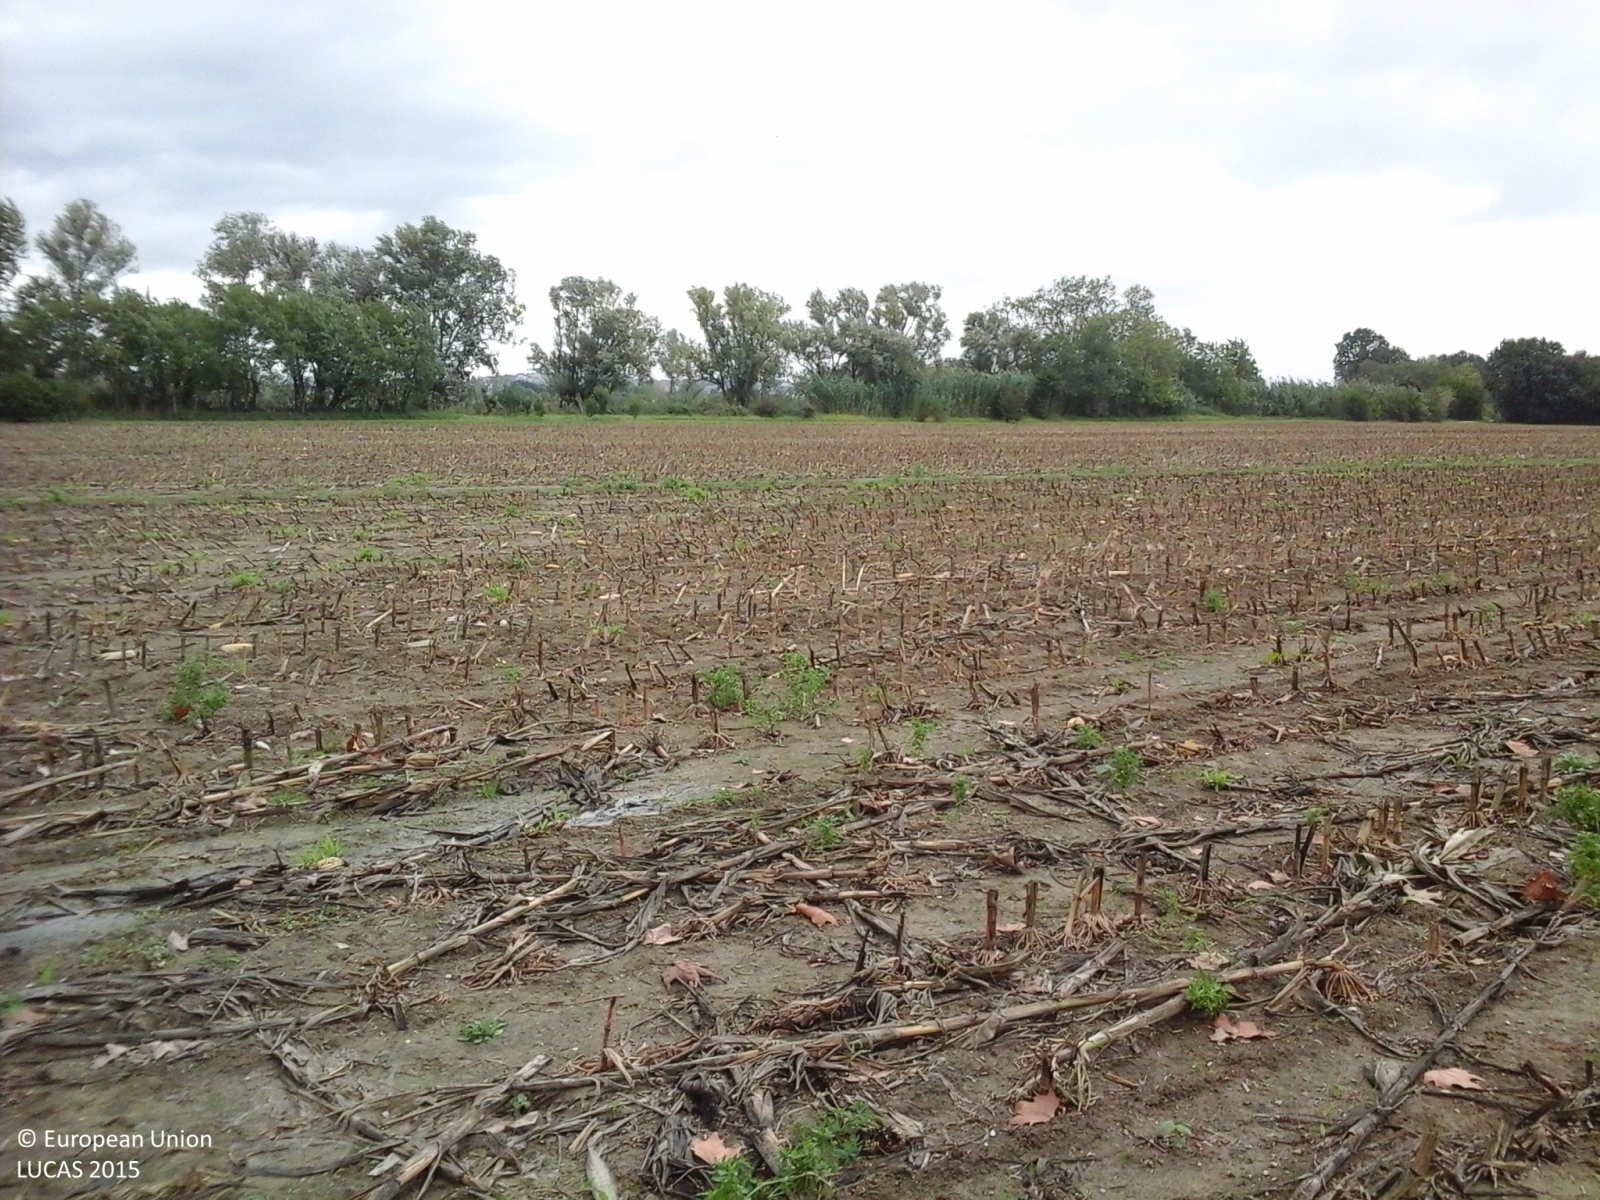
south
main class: Cropland
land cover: Maize
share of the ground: < 10 %
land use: Agriculture (excluding fallow land and kitchen gardens)
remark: Harvested field
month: October
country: IT
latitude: 43.6284
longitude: 13.3507
